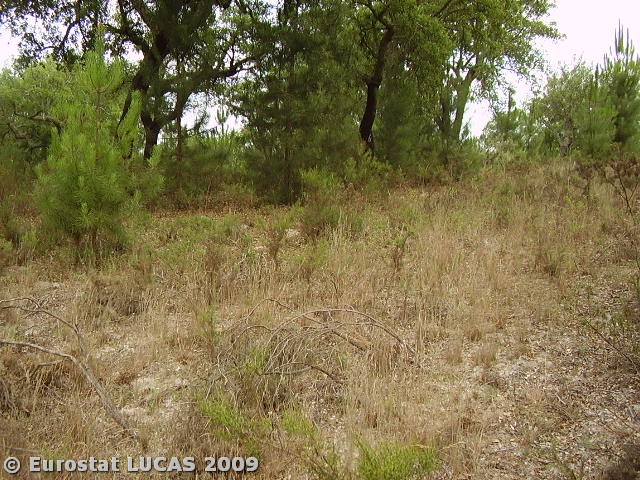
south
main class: Woodland
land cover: Broadleaved woodland
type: broadleaved evergreen forest
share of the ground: 25 - 50 %
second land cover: Spontaneously vegetated surfaces
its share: 25 - 50 %
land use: Forestry
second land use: Fallow land
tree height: > 5 m
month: June
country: PT
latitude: 38.9019
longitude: -8.1908
